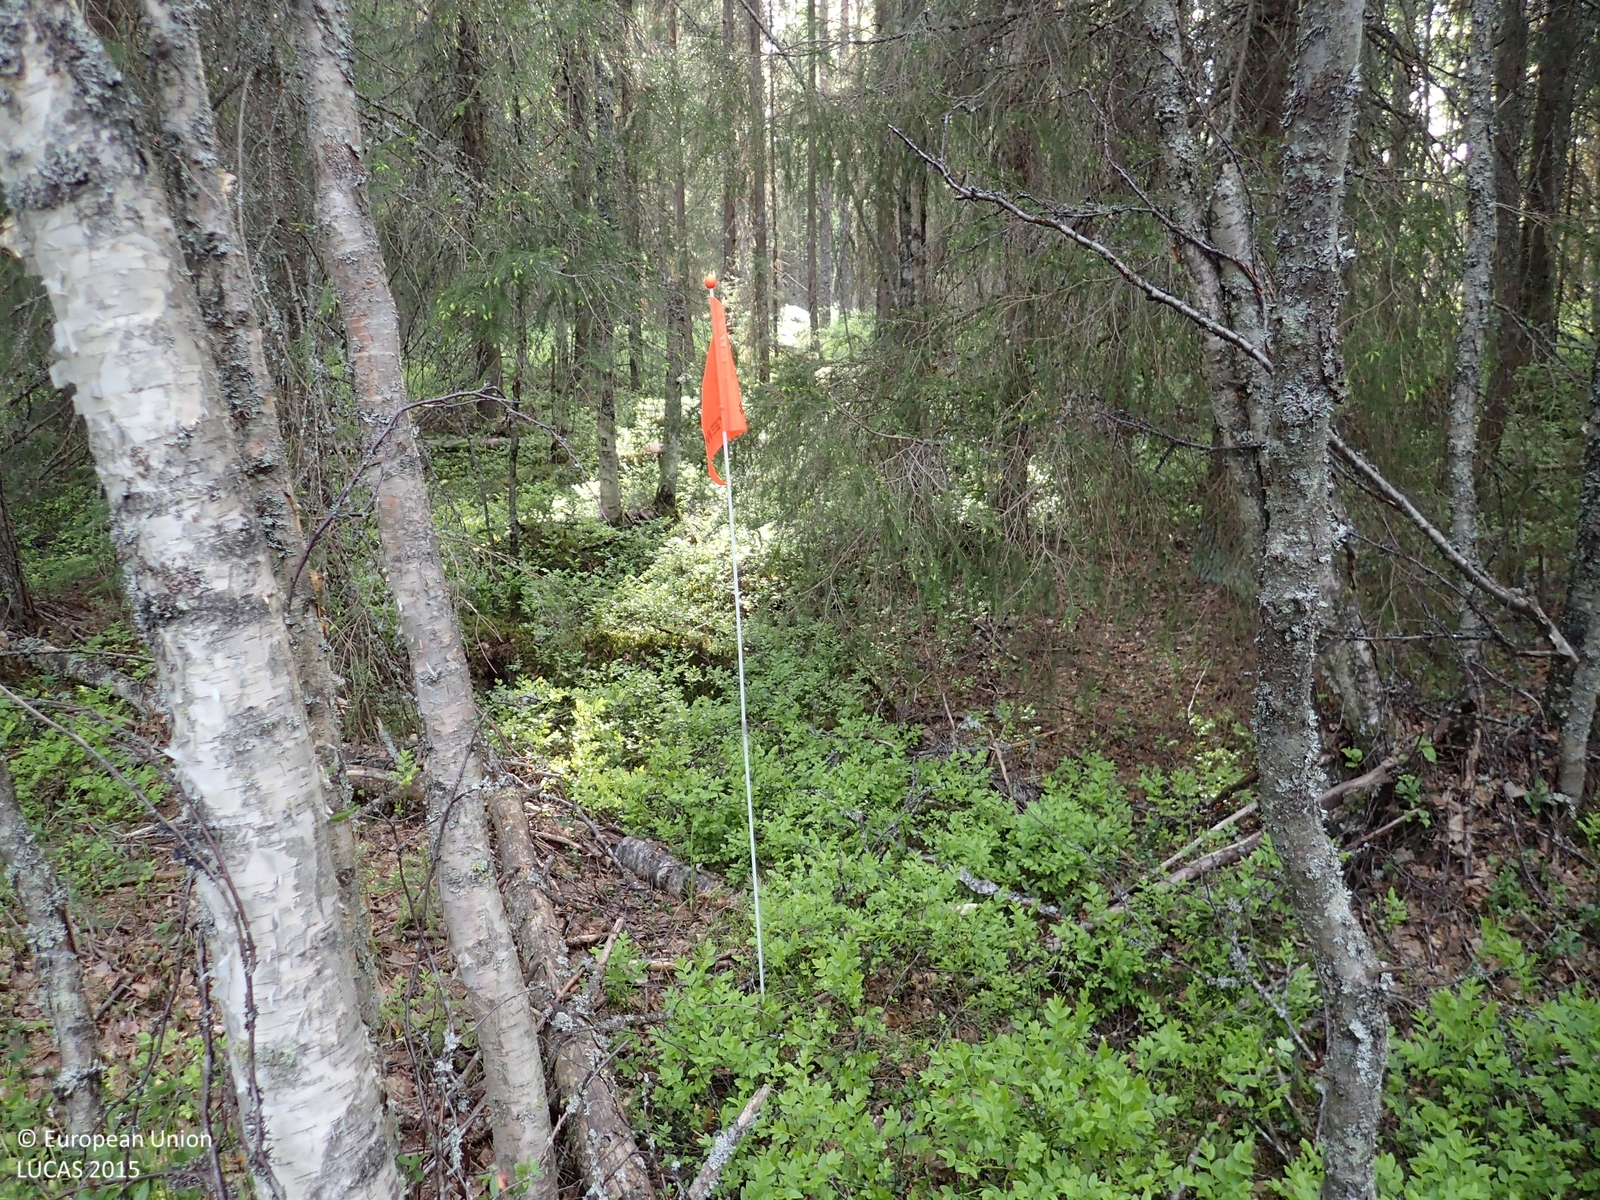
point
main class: Woodland
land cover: Spruce dominated coniferous woodland
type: boreal forest
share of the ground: > 75 %
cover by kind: coniferous forest trees 85 %, shrubs 10 %, broadleaved forest trees 5 %
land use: Forestry
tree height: > 5 m
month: June
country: FI
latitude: 62.3409
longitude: 22.5512
